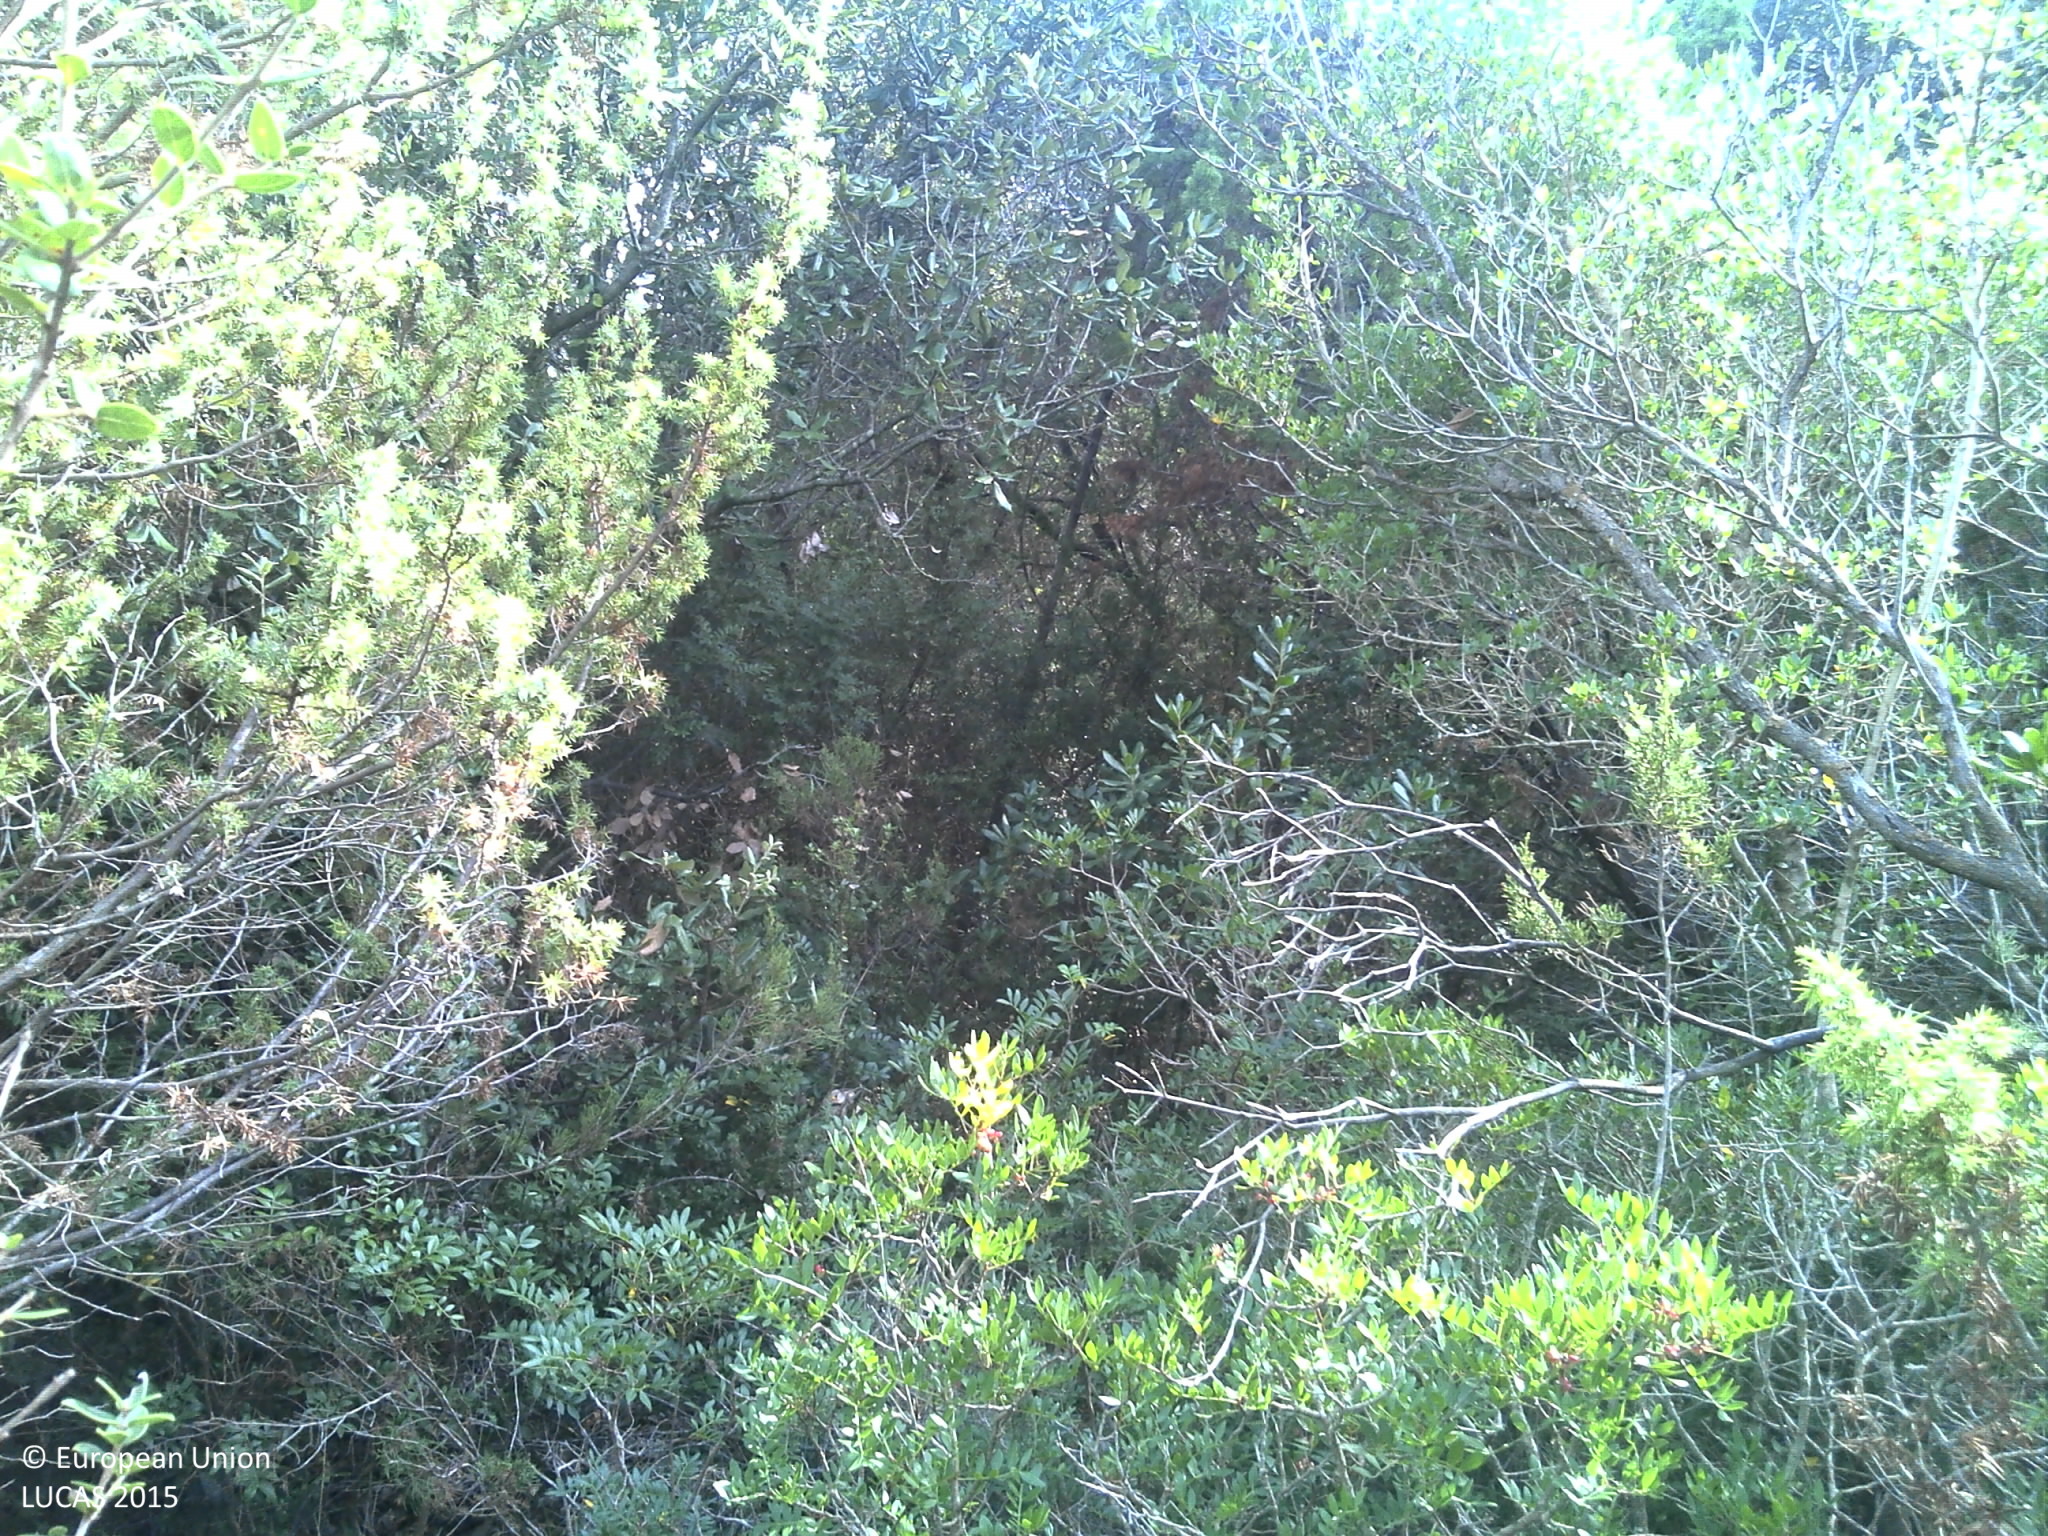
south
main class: Woodland
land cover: Pine dominated mixed woodland
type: coniferous forest of the mediterranean region
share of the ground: 25 - 50 %
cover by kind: shrubs 50 %, coniferous forest trees 20 %, herbaceous plants 15 %, broadleaved forest trees 10 %, consolidated bare surface 5 %
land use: Semi-natural and natural areas not in use
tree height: > 5 m
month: September
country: HR
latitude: 44.1478
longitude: 14.8303
